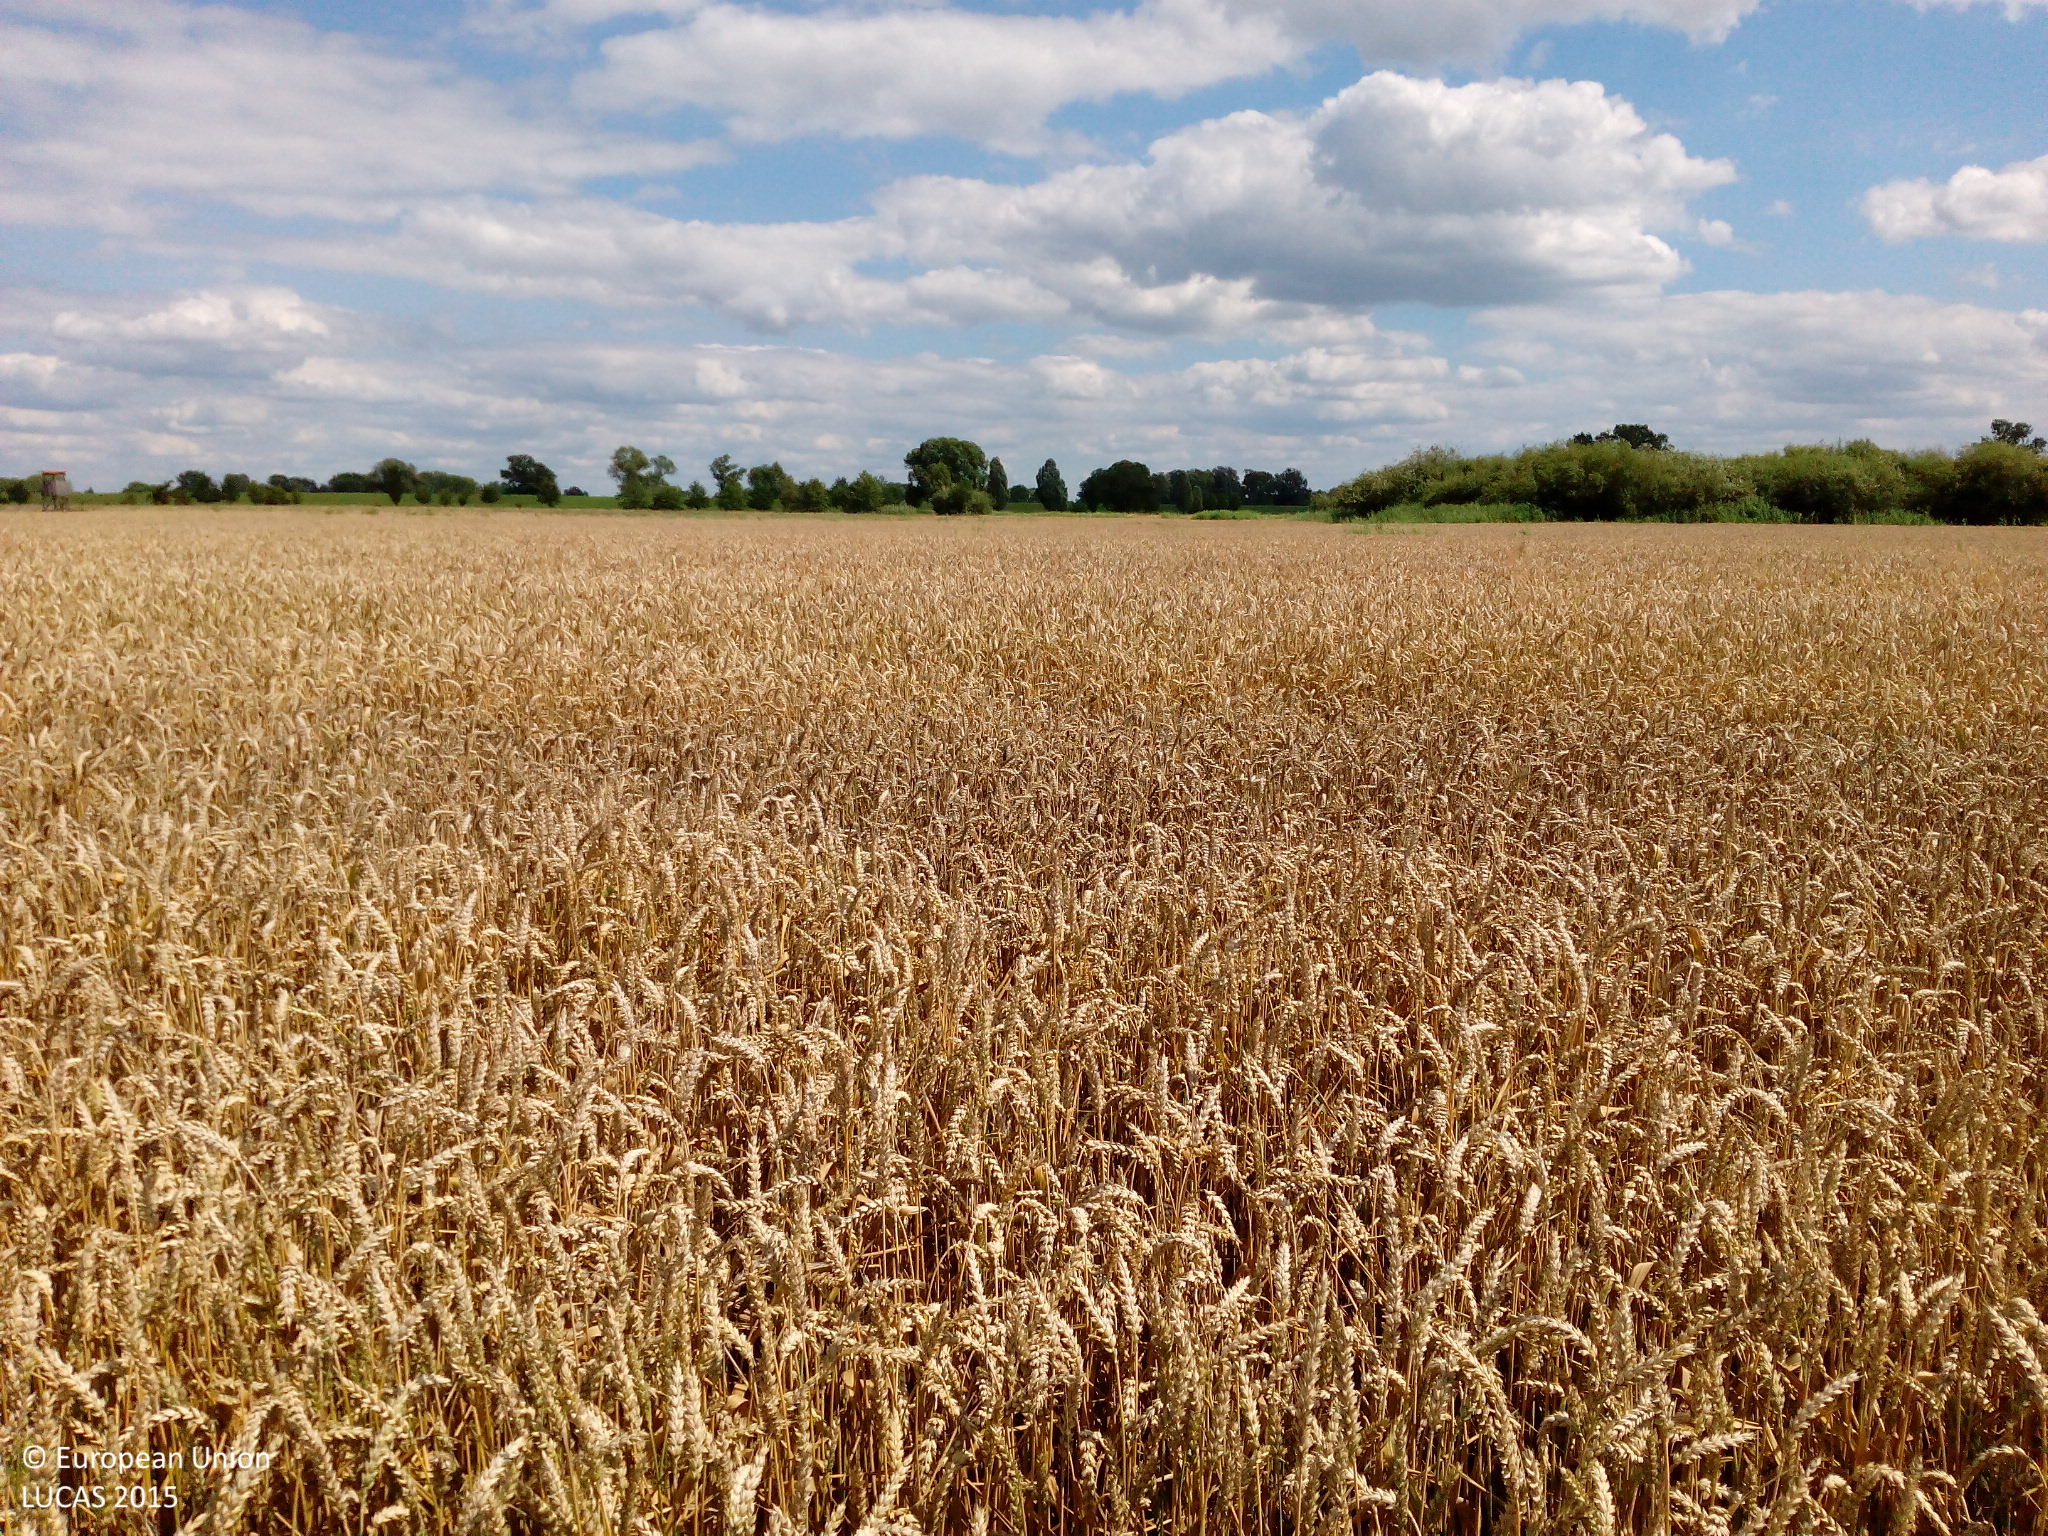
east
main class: Cropland
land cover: Common wheat
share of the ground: > 75 %
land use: Agriculture (excluding fallow land and kitchen gardens)
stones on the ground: < 10 %
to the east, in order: Common wheat
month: July
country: DE
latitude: 52.6541
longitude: 14.4510
